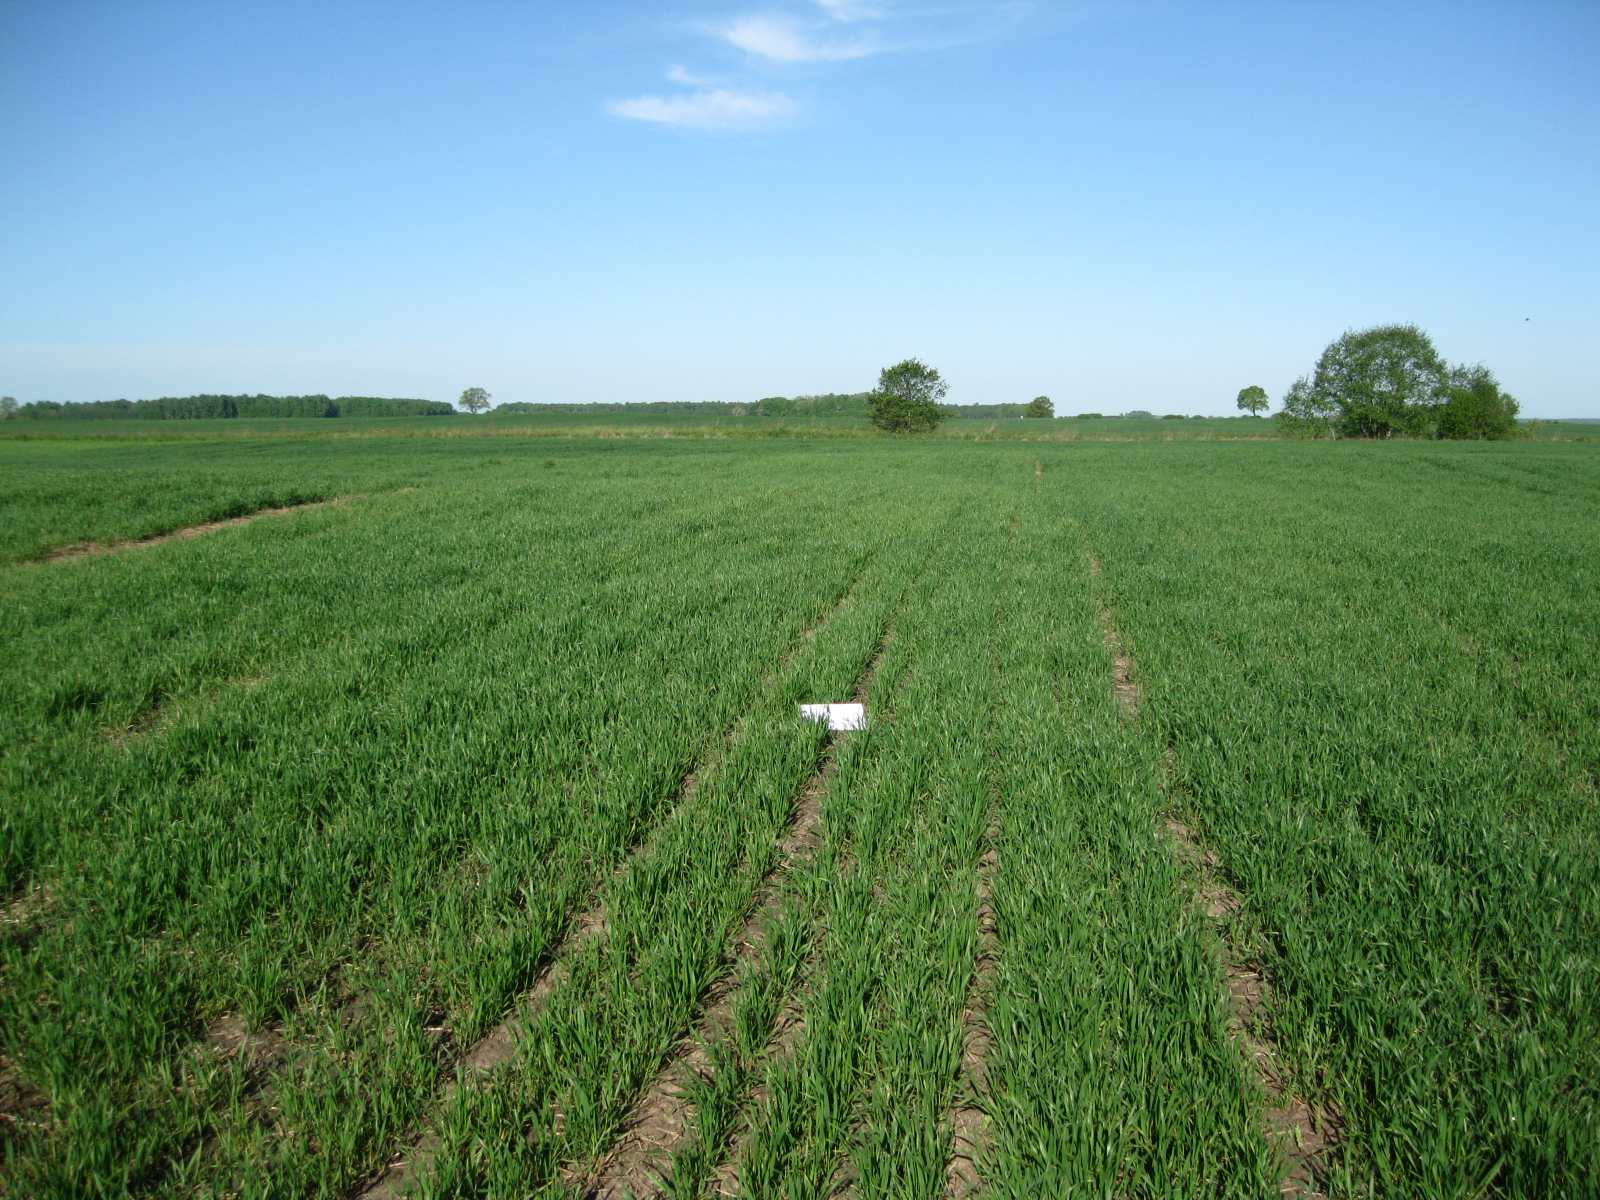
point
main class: Cropland
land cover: Common wheat
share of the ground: > 75 %
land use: Agriculture (excluding fallow land and kitchen gardens)
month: May
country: LT
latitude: 56.1698
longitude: 23.9524
